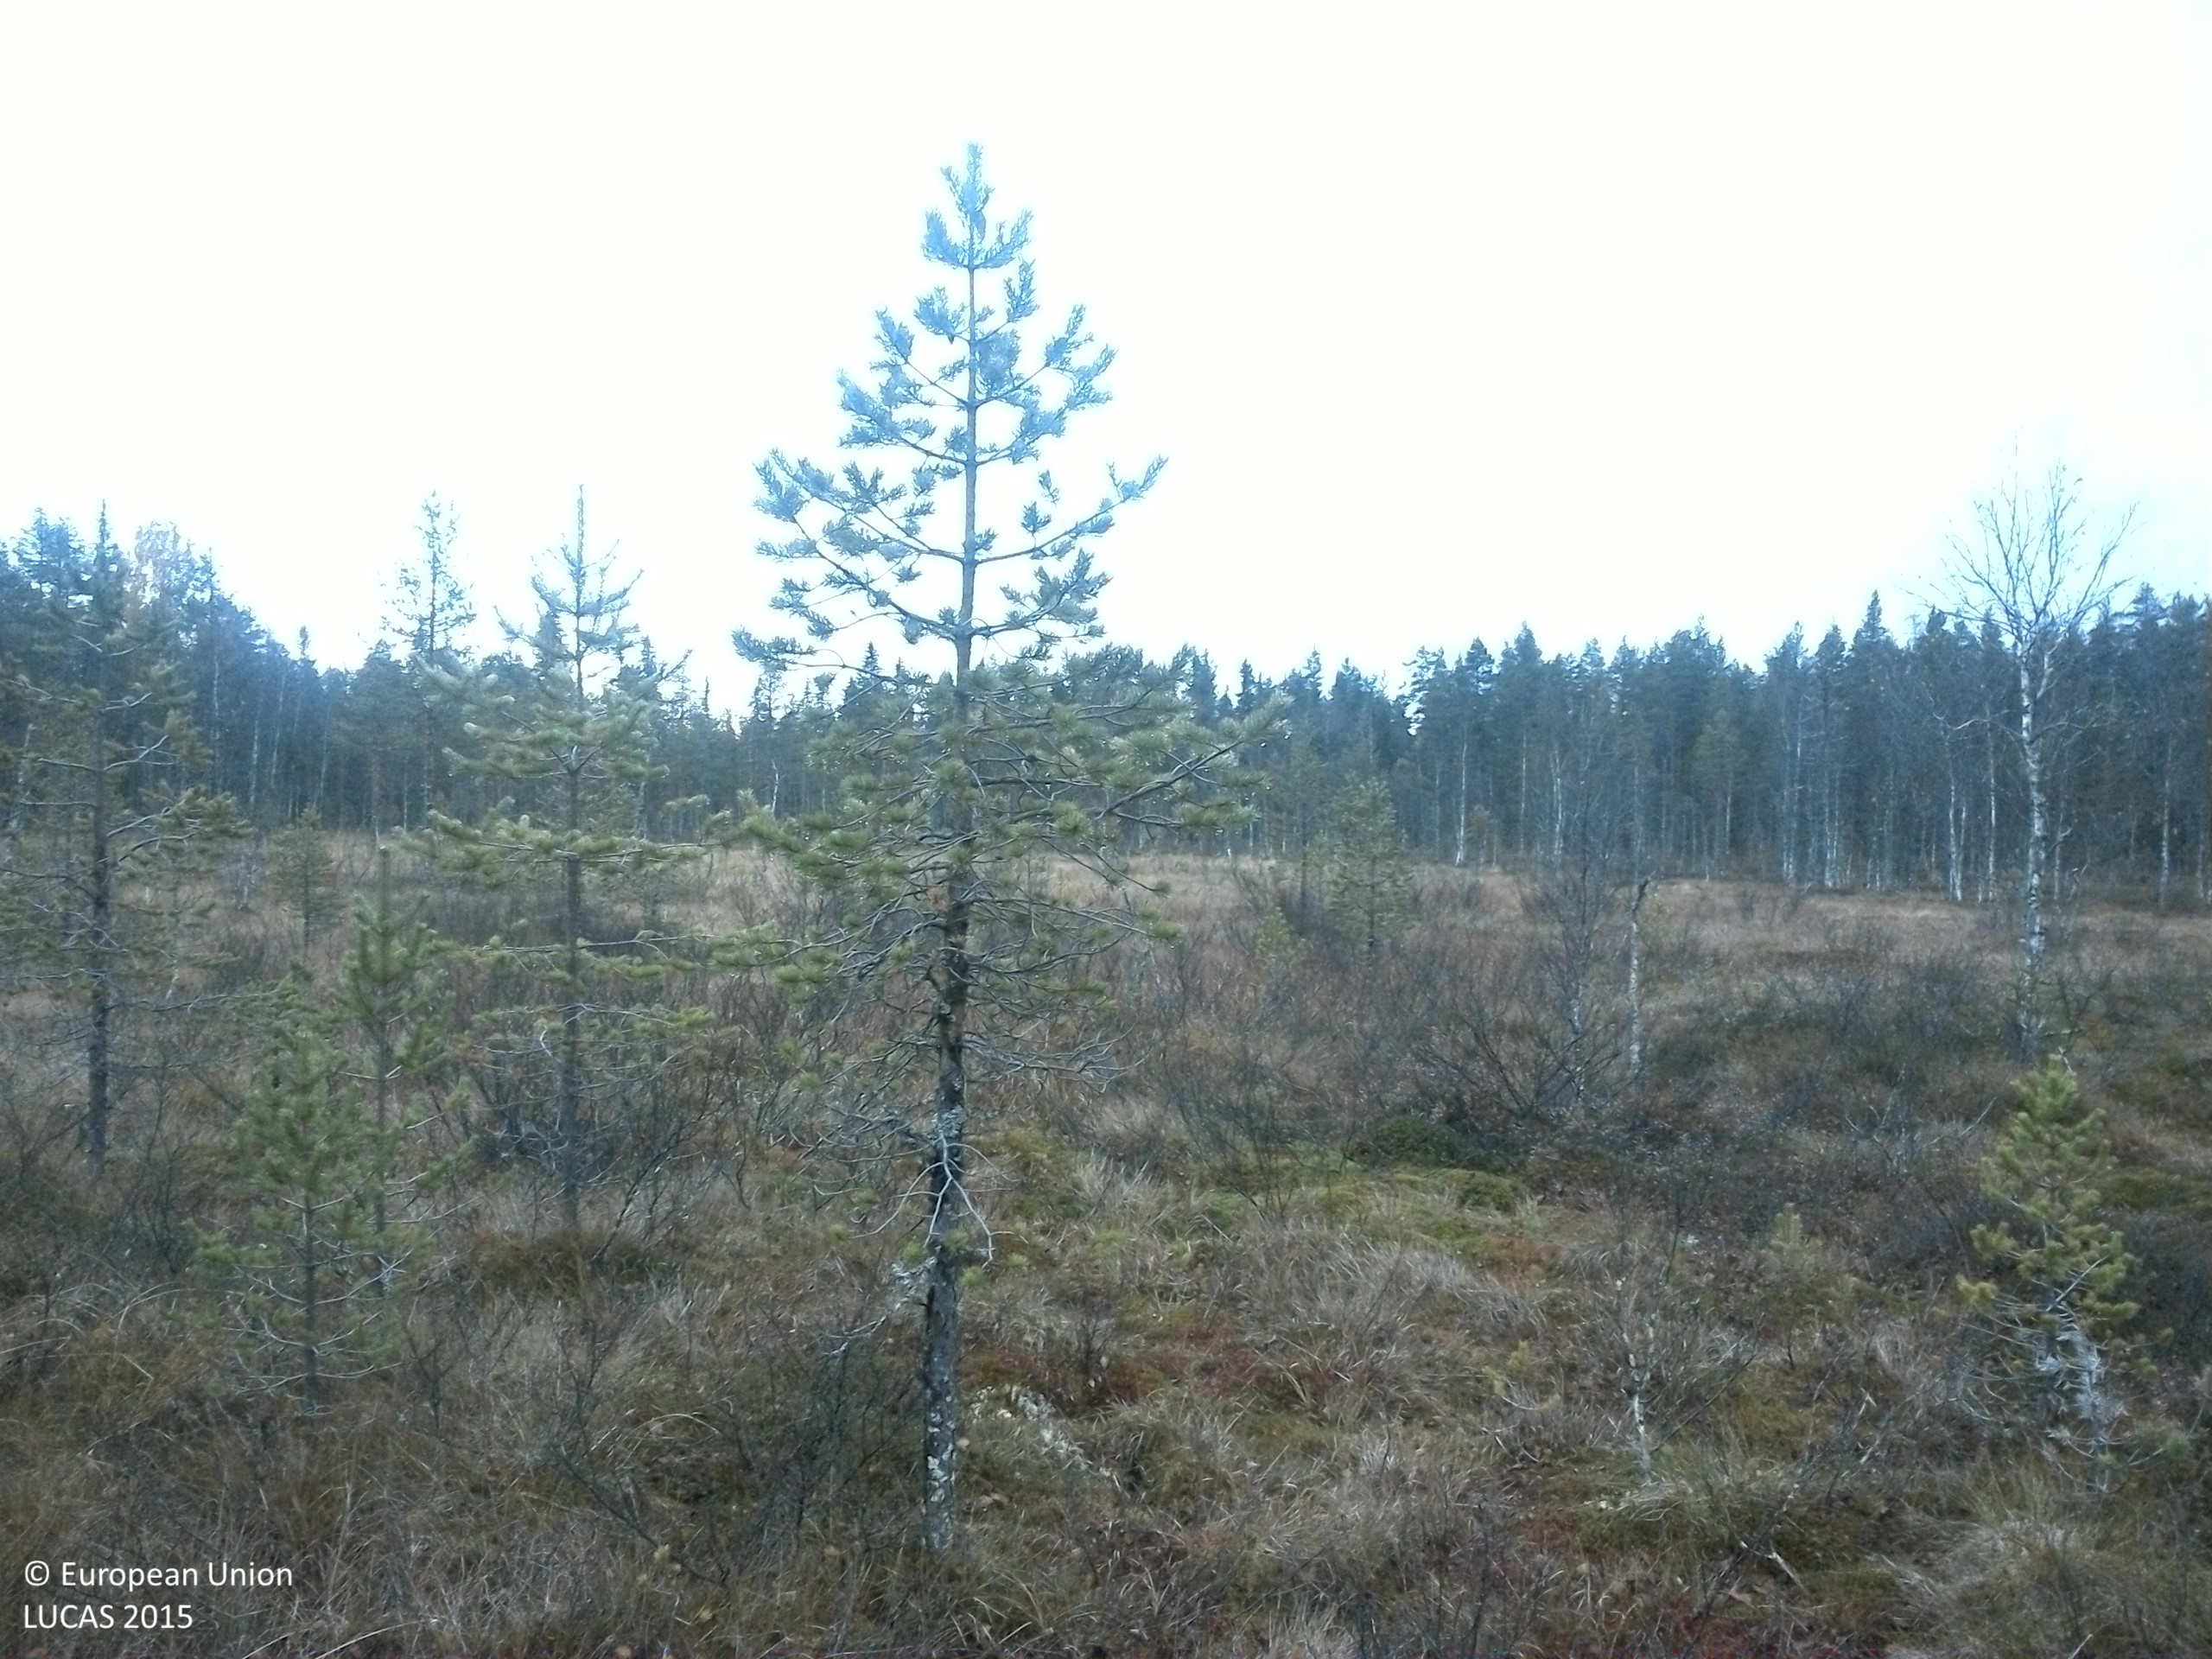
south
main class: Woodland
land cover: Pine dominated mixed woodland
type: mire and swamp forests
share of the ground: 10 - 25 %
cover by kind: shrubs 30 %, herbaceous plants 30 %, lichens and mosses 30 %, coniferous forest trees 5 %, broadleaved forest trees 5 %
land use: Semi-natural and natural areas not in use
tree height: < 5 m
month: October
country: SE
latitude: 64.0667
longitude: 16.0171
